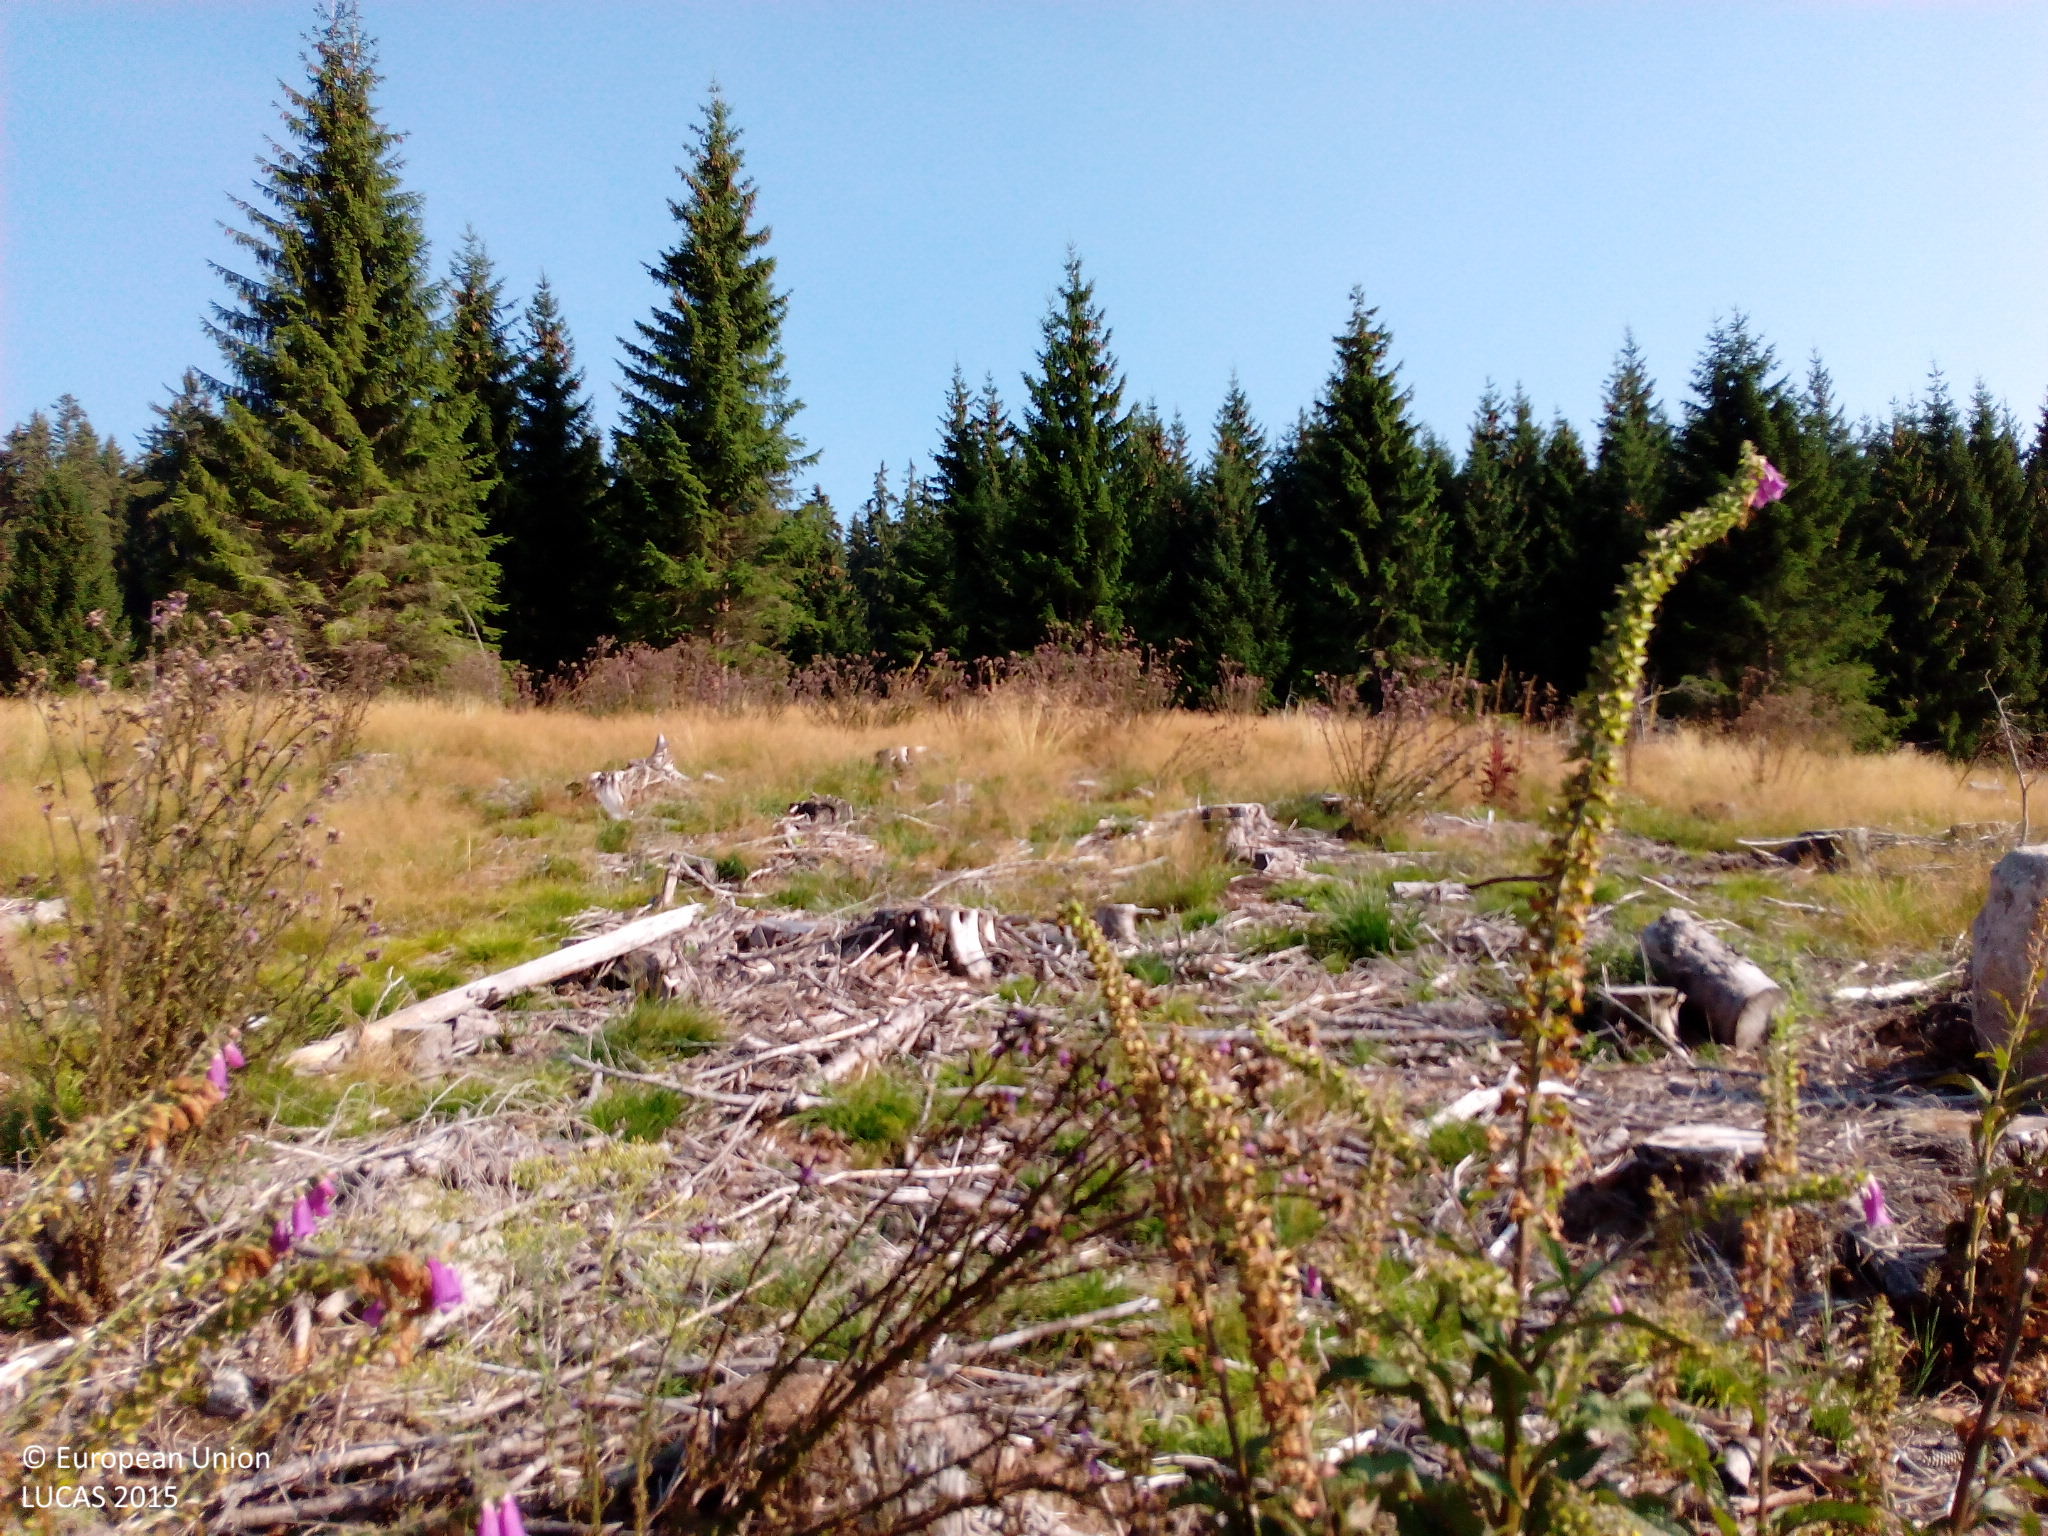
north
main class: Grassland
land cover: Spontaneously vegetated surfaces
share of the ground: 50 - 75 %
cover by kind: herbaceous plants 50 %, unconsolidated bare surface 50 %
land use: Forestry
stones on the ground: 10 - 25 %
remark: Clear cut
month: August
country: DE
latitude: 47.8115
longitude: 8.1183
